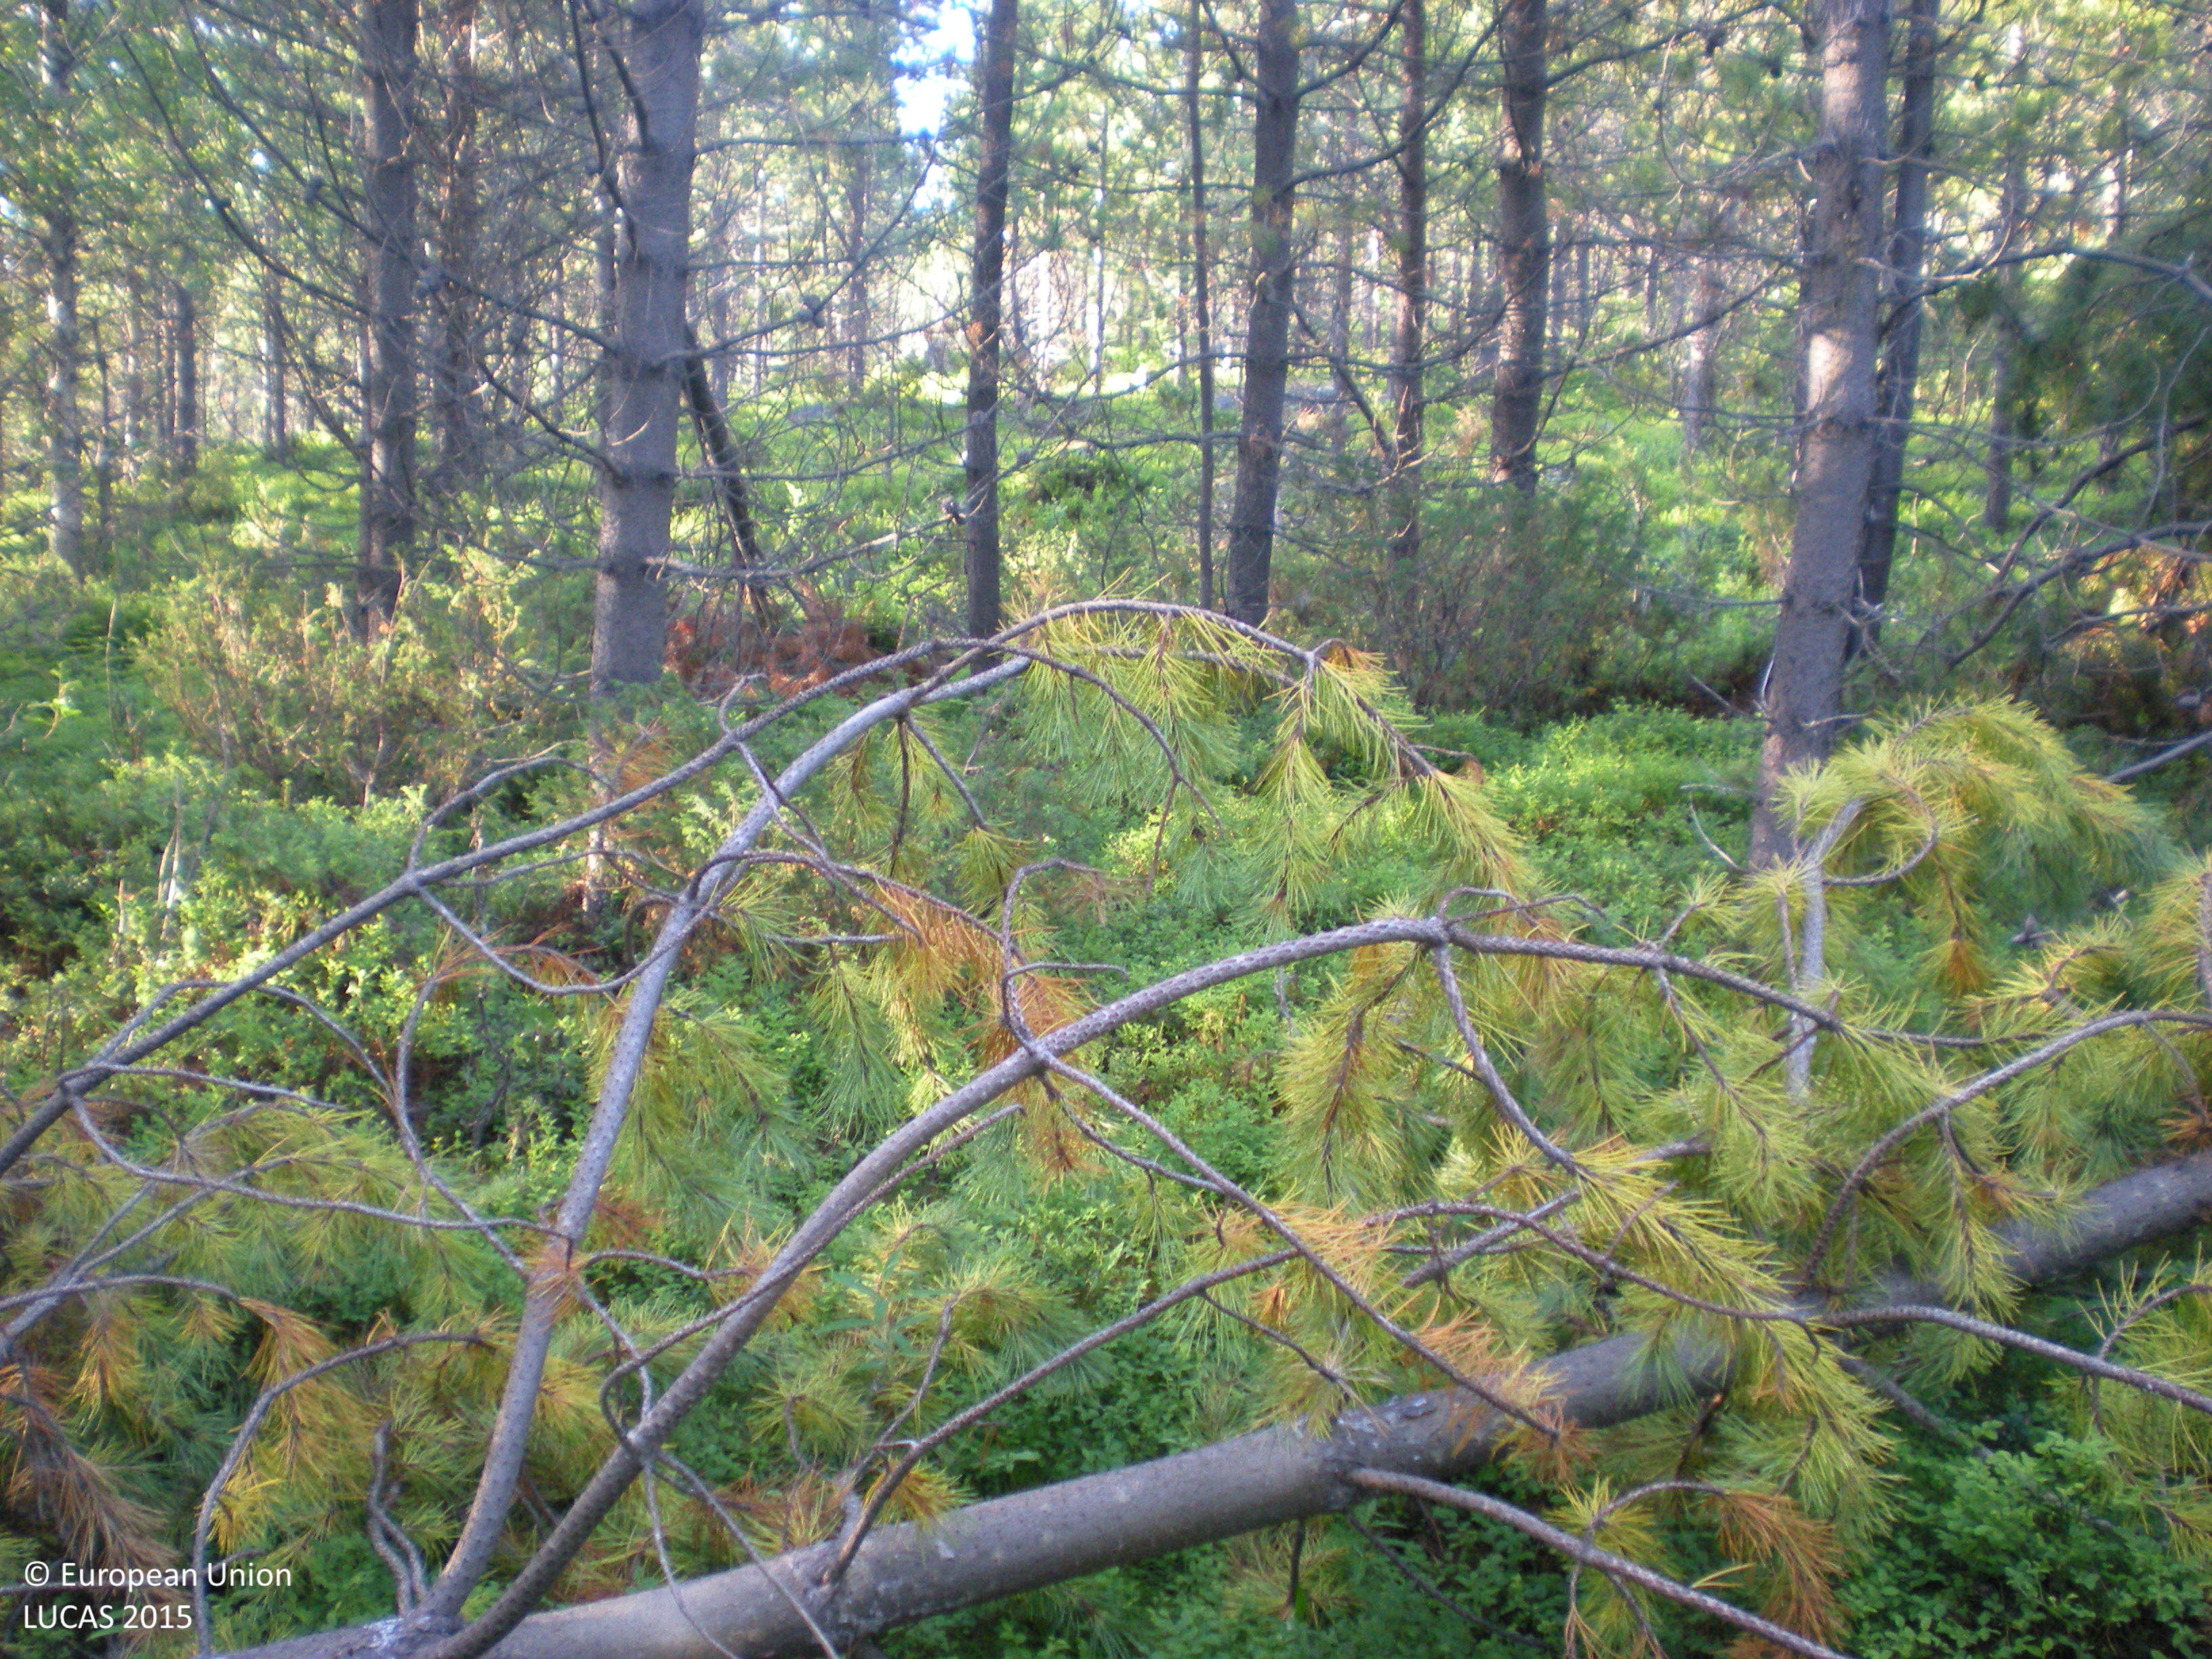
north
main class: Woodland
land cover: Pine dominated coniferous woodland
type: exotic forest
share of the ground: 50 - 75 %
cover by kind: coniferous forest trees 75 %, shrubs 20 %, consolidated bare surface 5 %
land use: Forestry
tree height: > 5 m
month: August
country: SE
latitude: 66.2672
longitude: 18.0360
